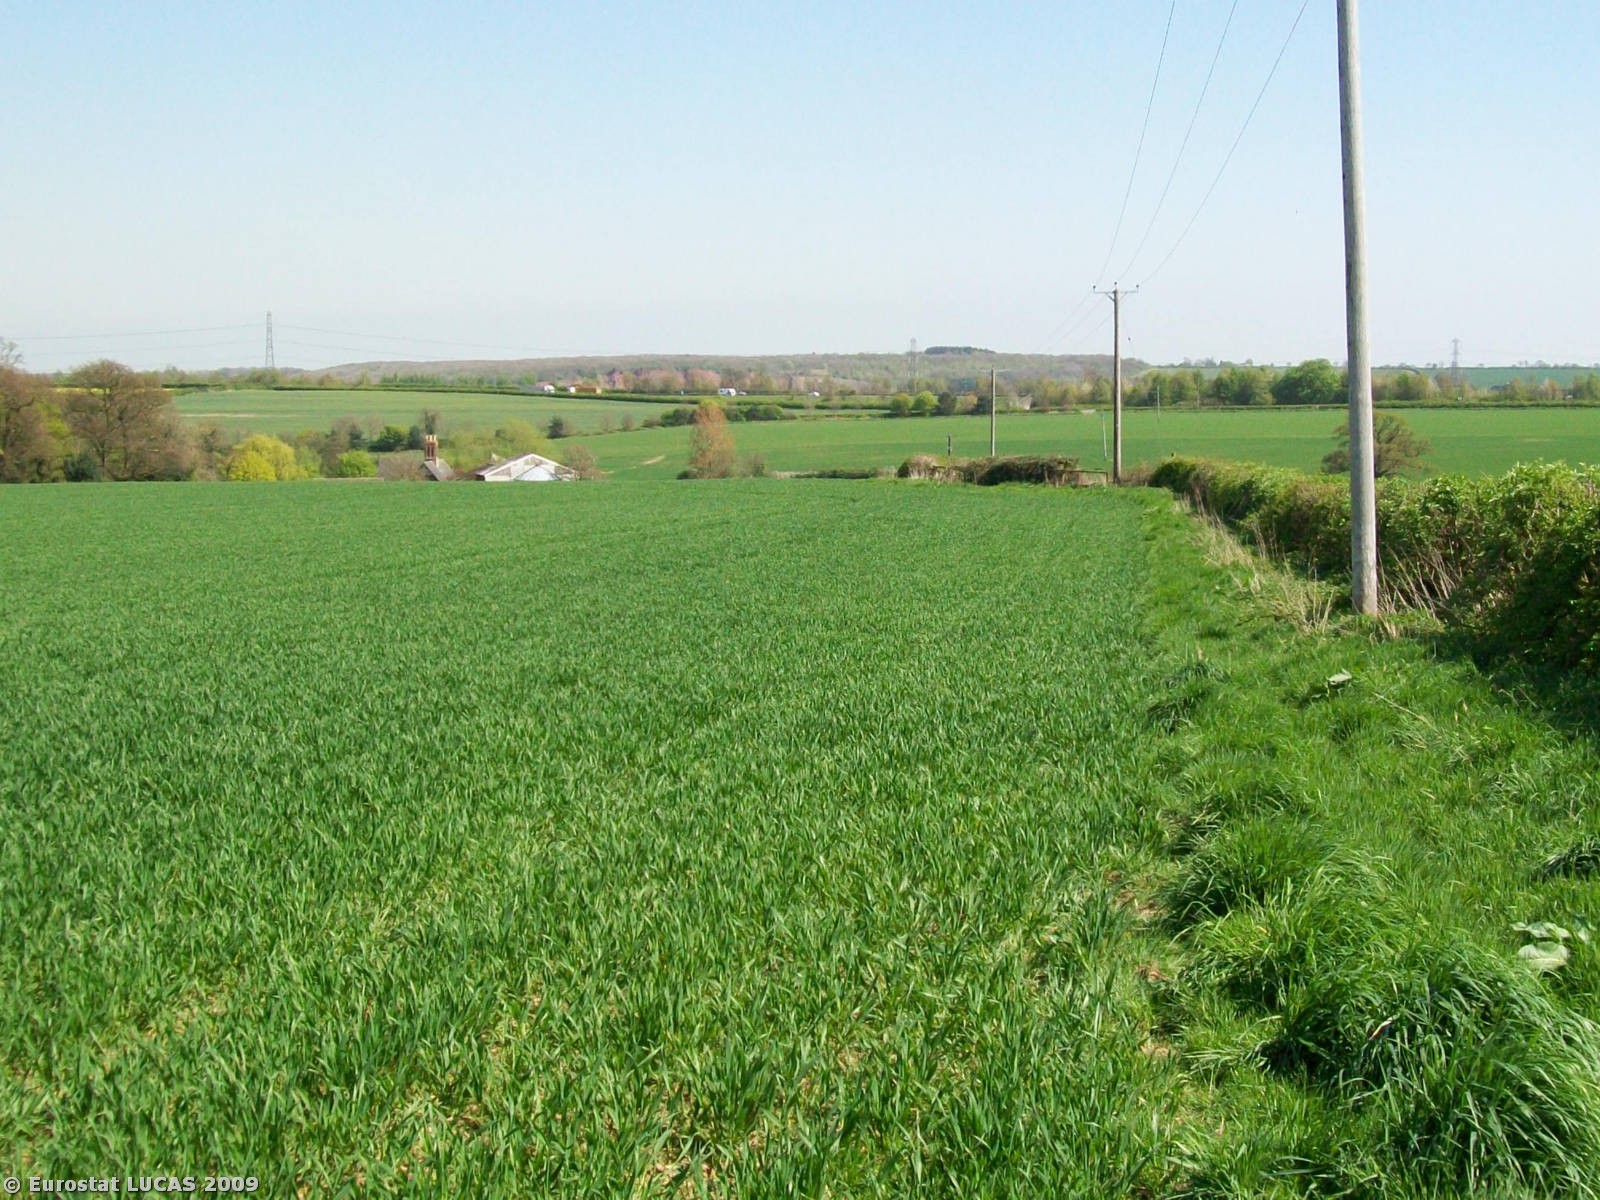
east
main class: Cropland
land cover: Common wheat
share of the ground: > 75 %
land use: Agriculture (excluding fallow land and kitchen gardens)
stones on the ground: < 10 %
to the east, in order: Common wheat
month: April
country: GB
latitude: 52.7867
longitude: -1.4224
